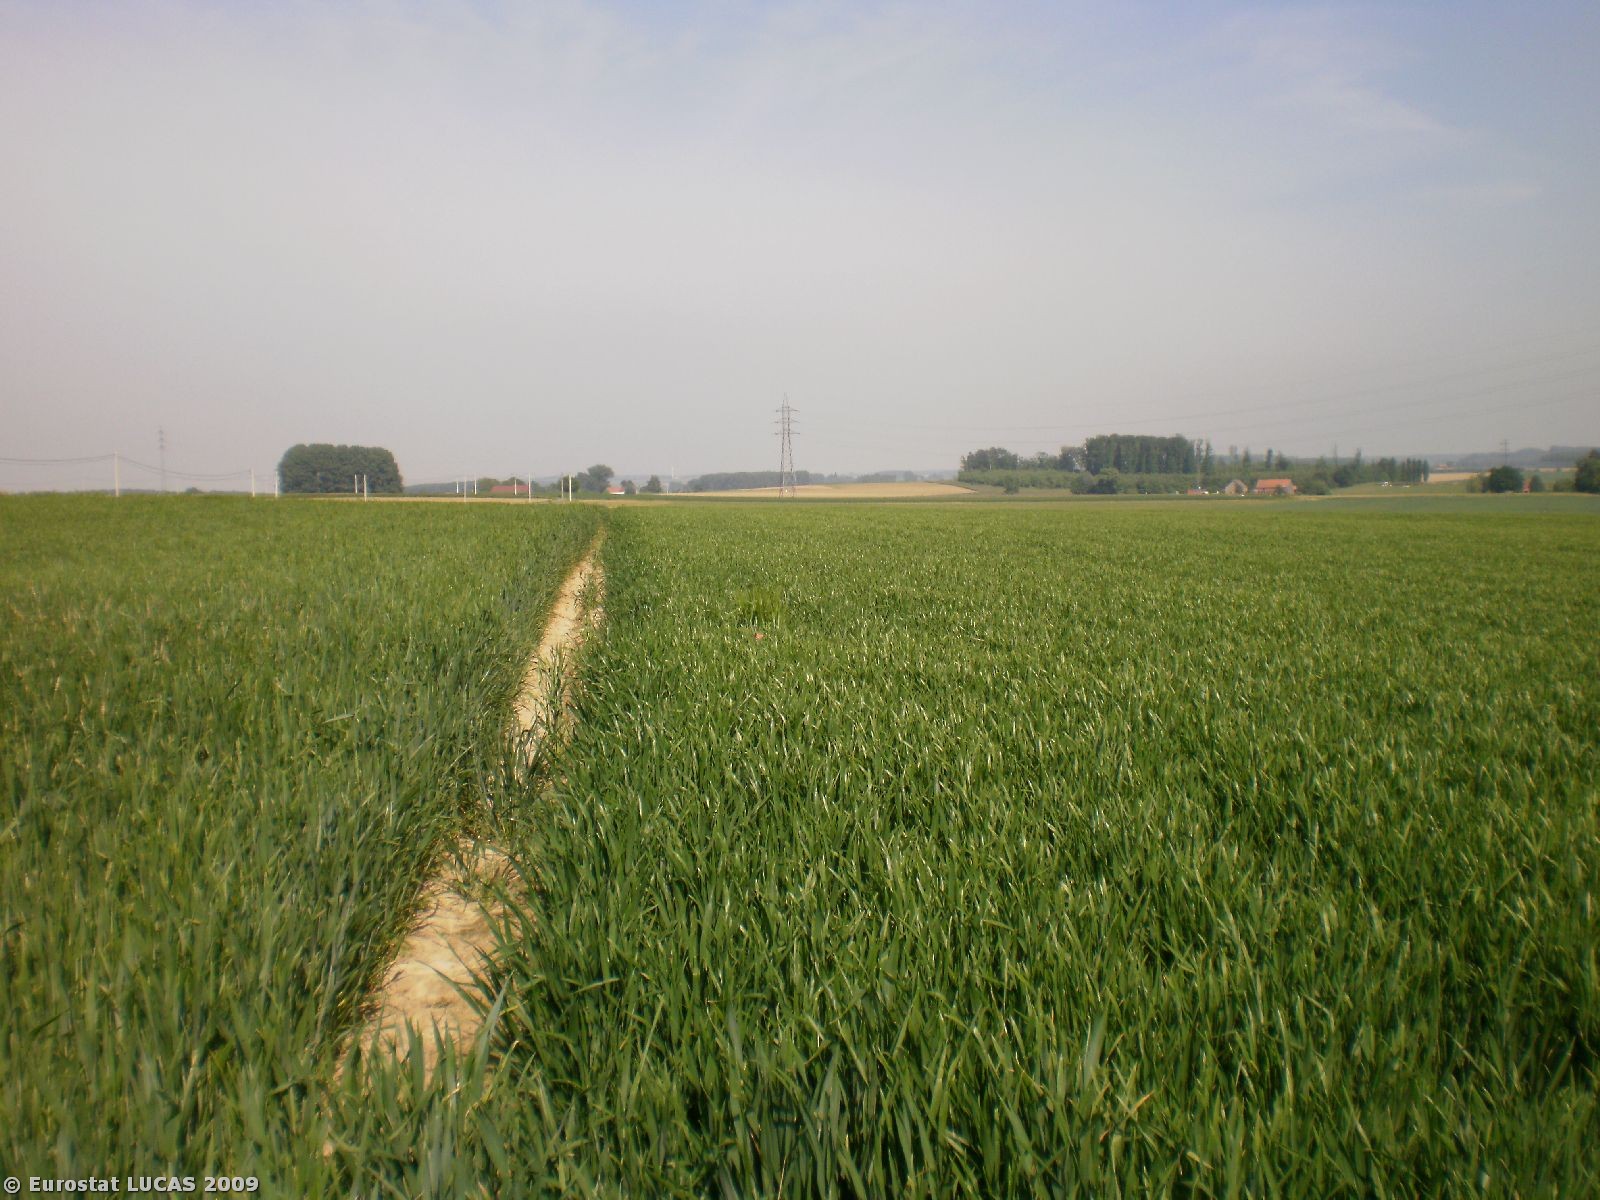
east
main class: Cropland
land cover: Barley
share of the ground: > 75 %
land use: Agriculture (excluding fallow land and kitchen gardens)
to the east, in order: Barley
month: May
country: BE
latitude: 50.6295
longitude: 3.8156
